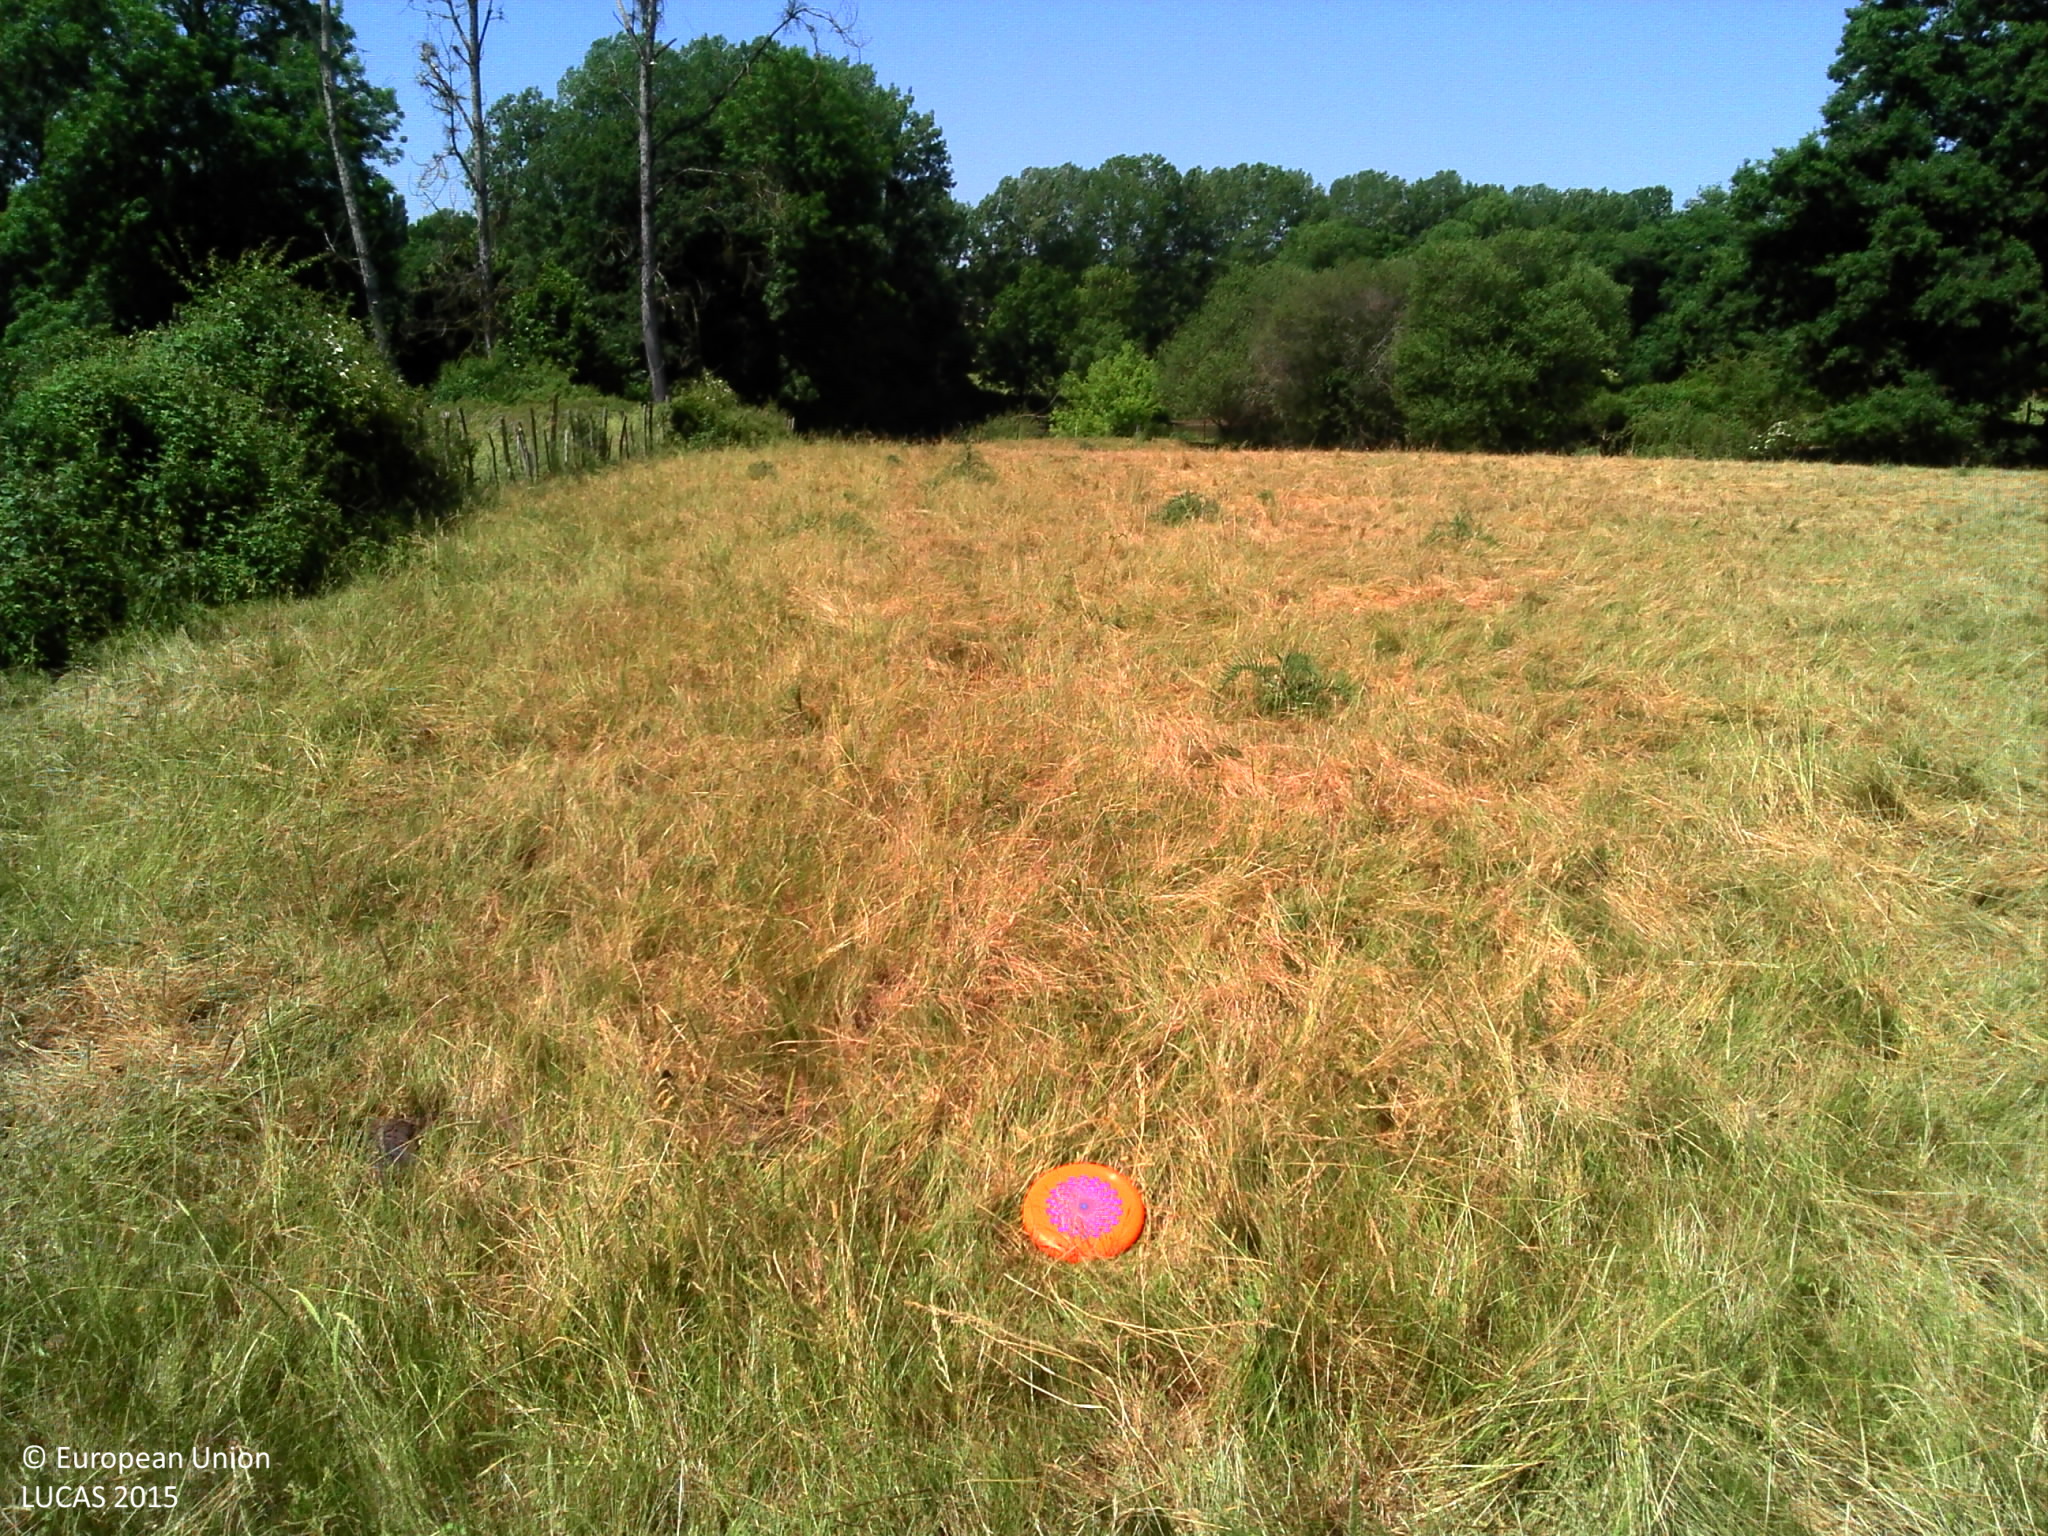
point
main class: Grassland
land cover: Grassland without tree/shrub cover
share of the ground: > 75 %
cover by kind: herbaceous plants 100 %
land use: Agriculture (excluding fallow land and kitchen gardens)
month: June
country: FR
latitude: 46.1070
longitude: 0.6837
